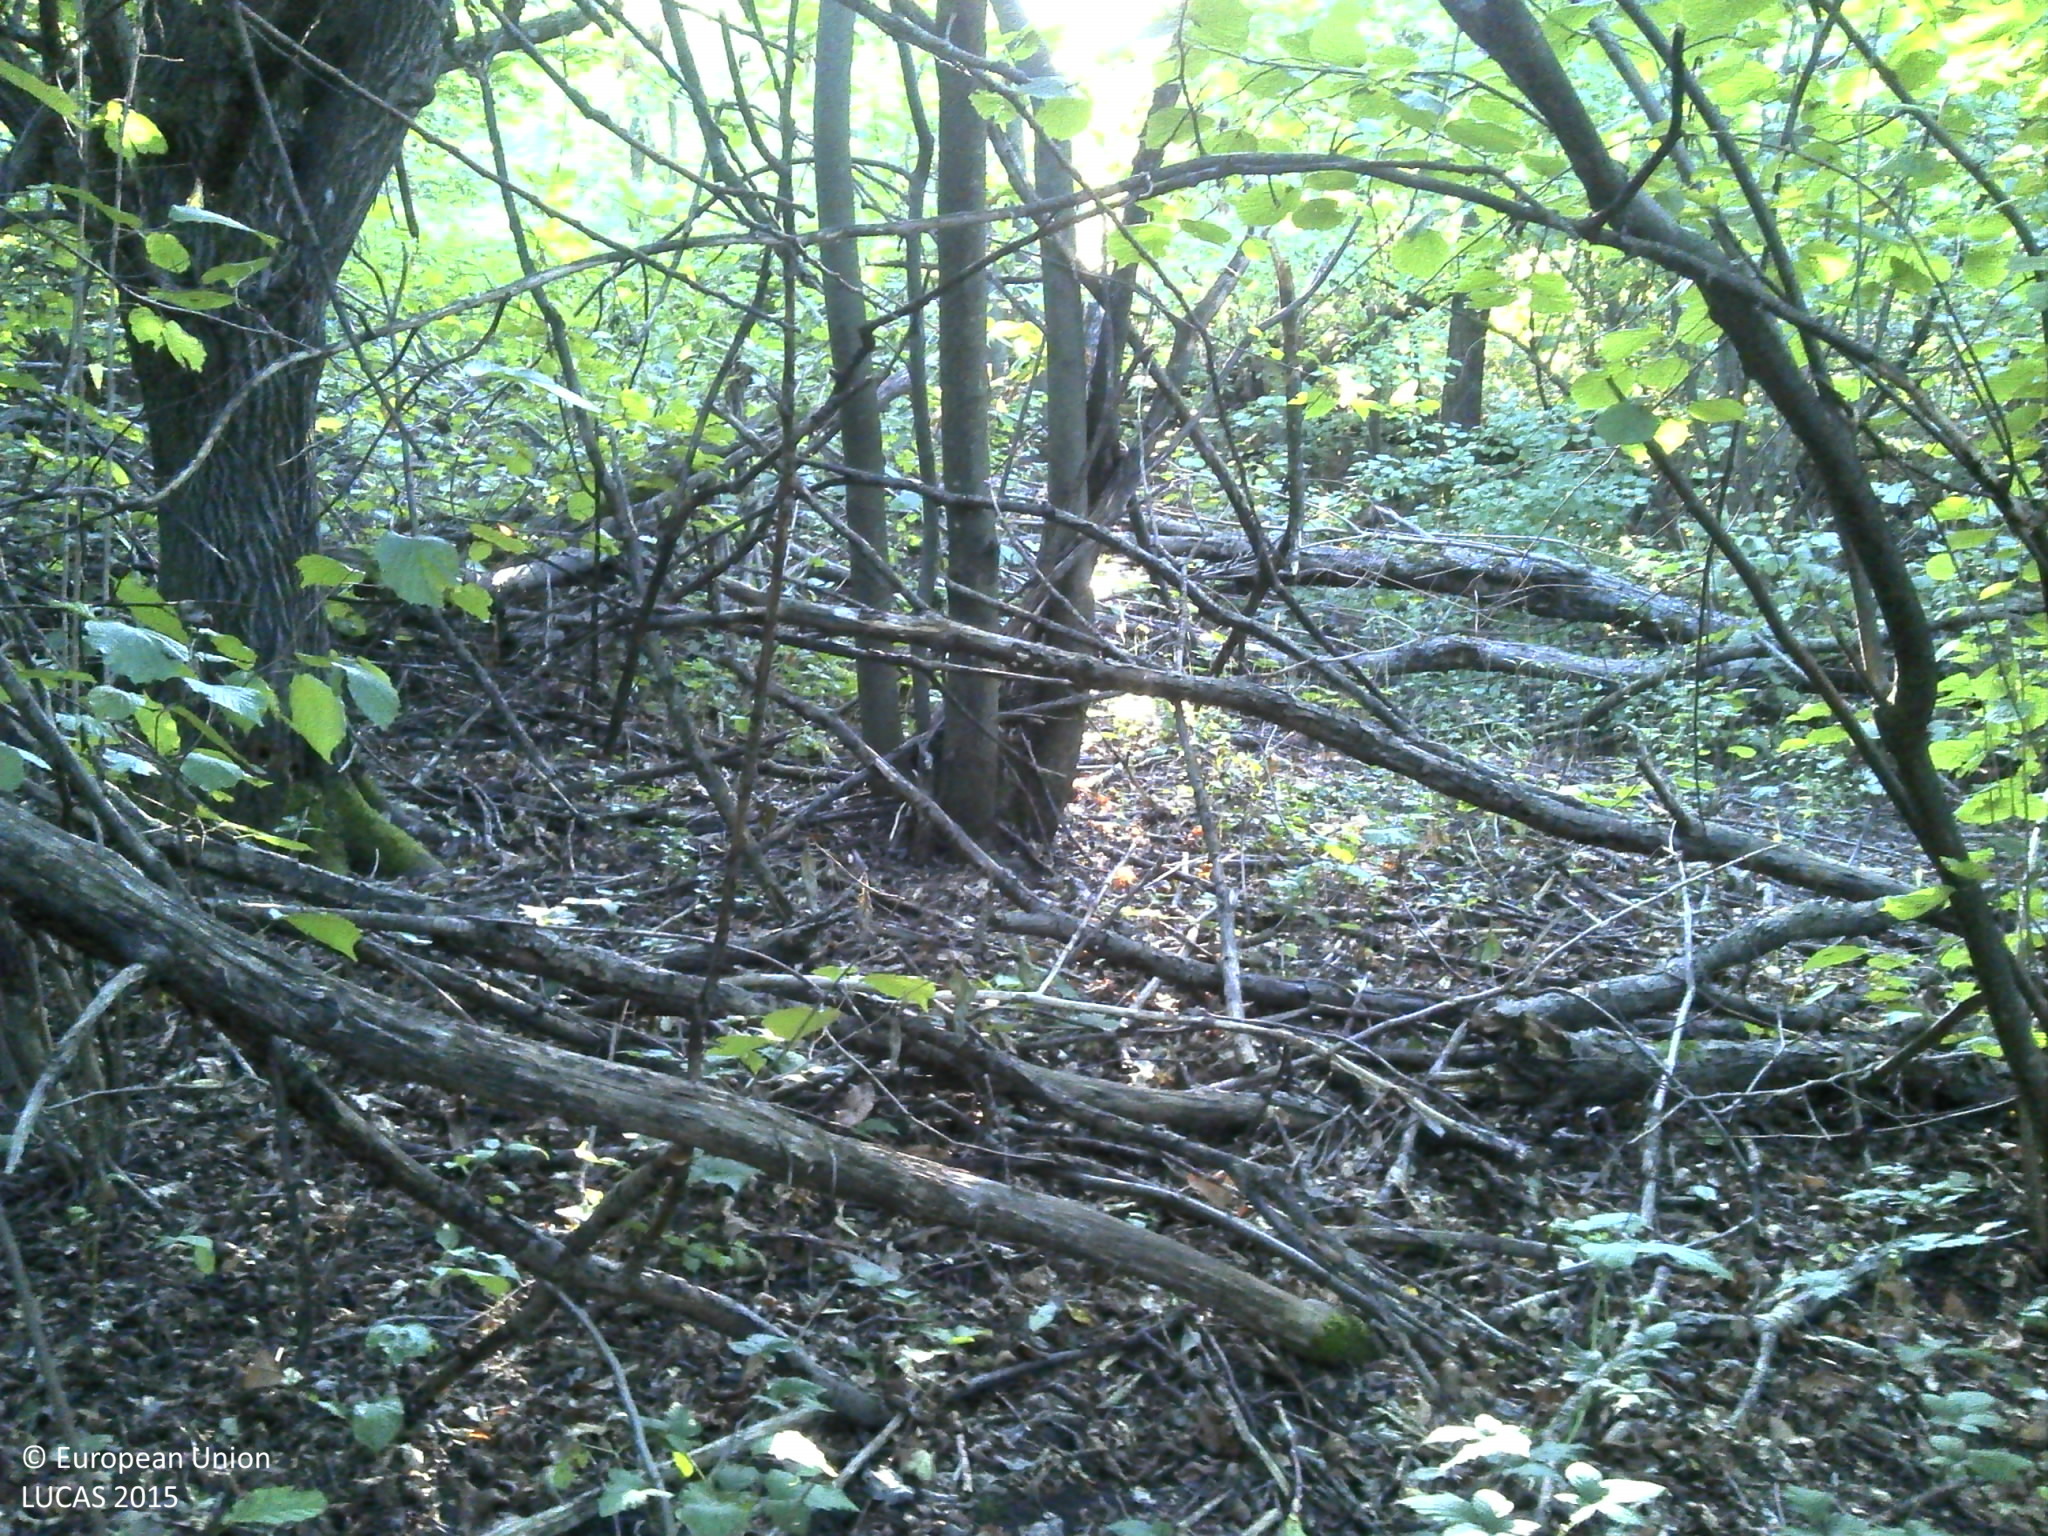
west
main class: Woodland
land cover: Broadleaved woodland
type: acidophilous oak and oak-birch forest
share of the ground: > 75 %
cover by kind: broadleaved forest trees 100 %
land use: Forestry
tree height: > 5 m
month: August
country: HR
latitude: 45.3140
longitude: 16.3368
